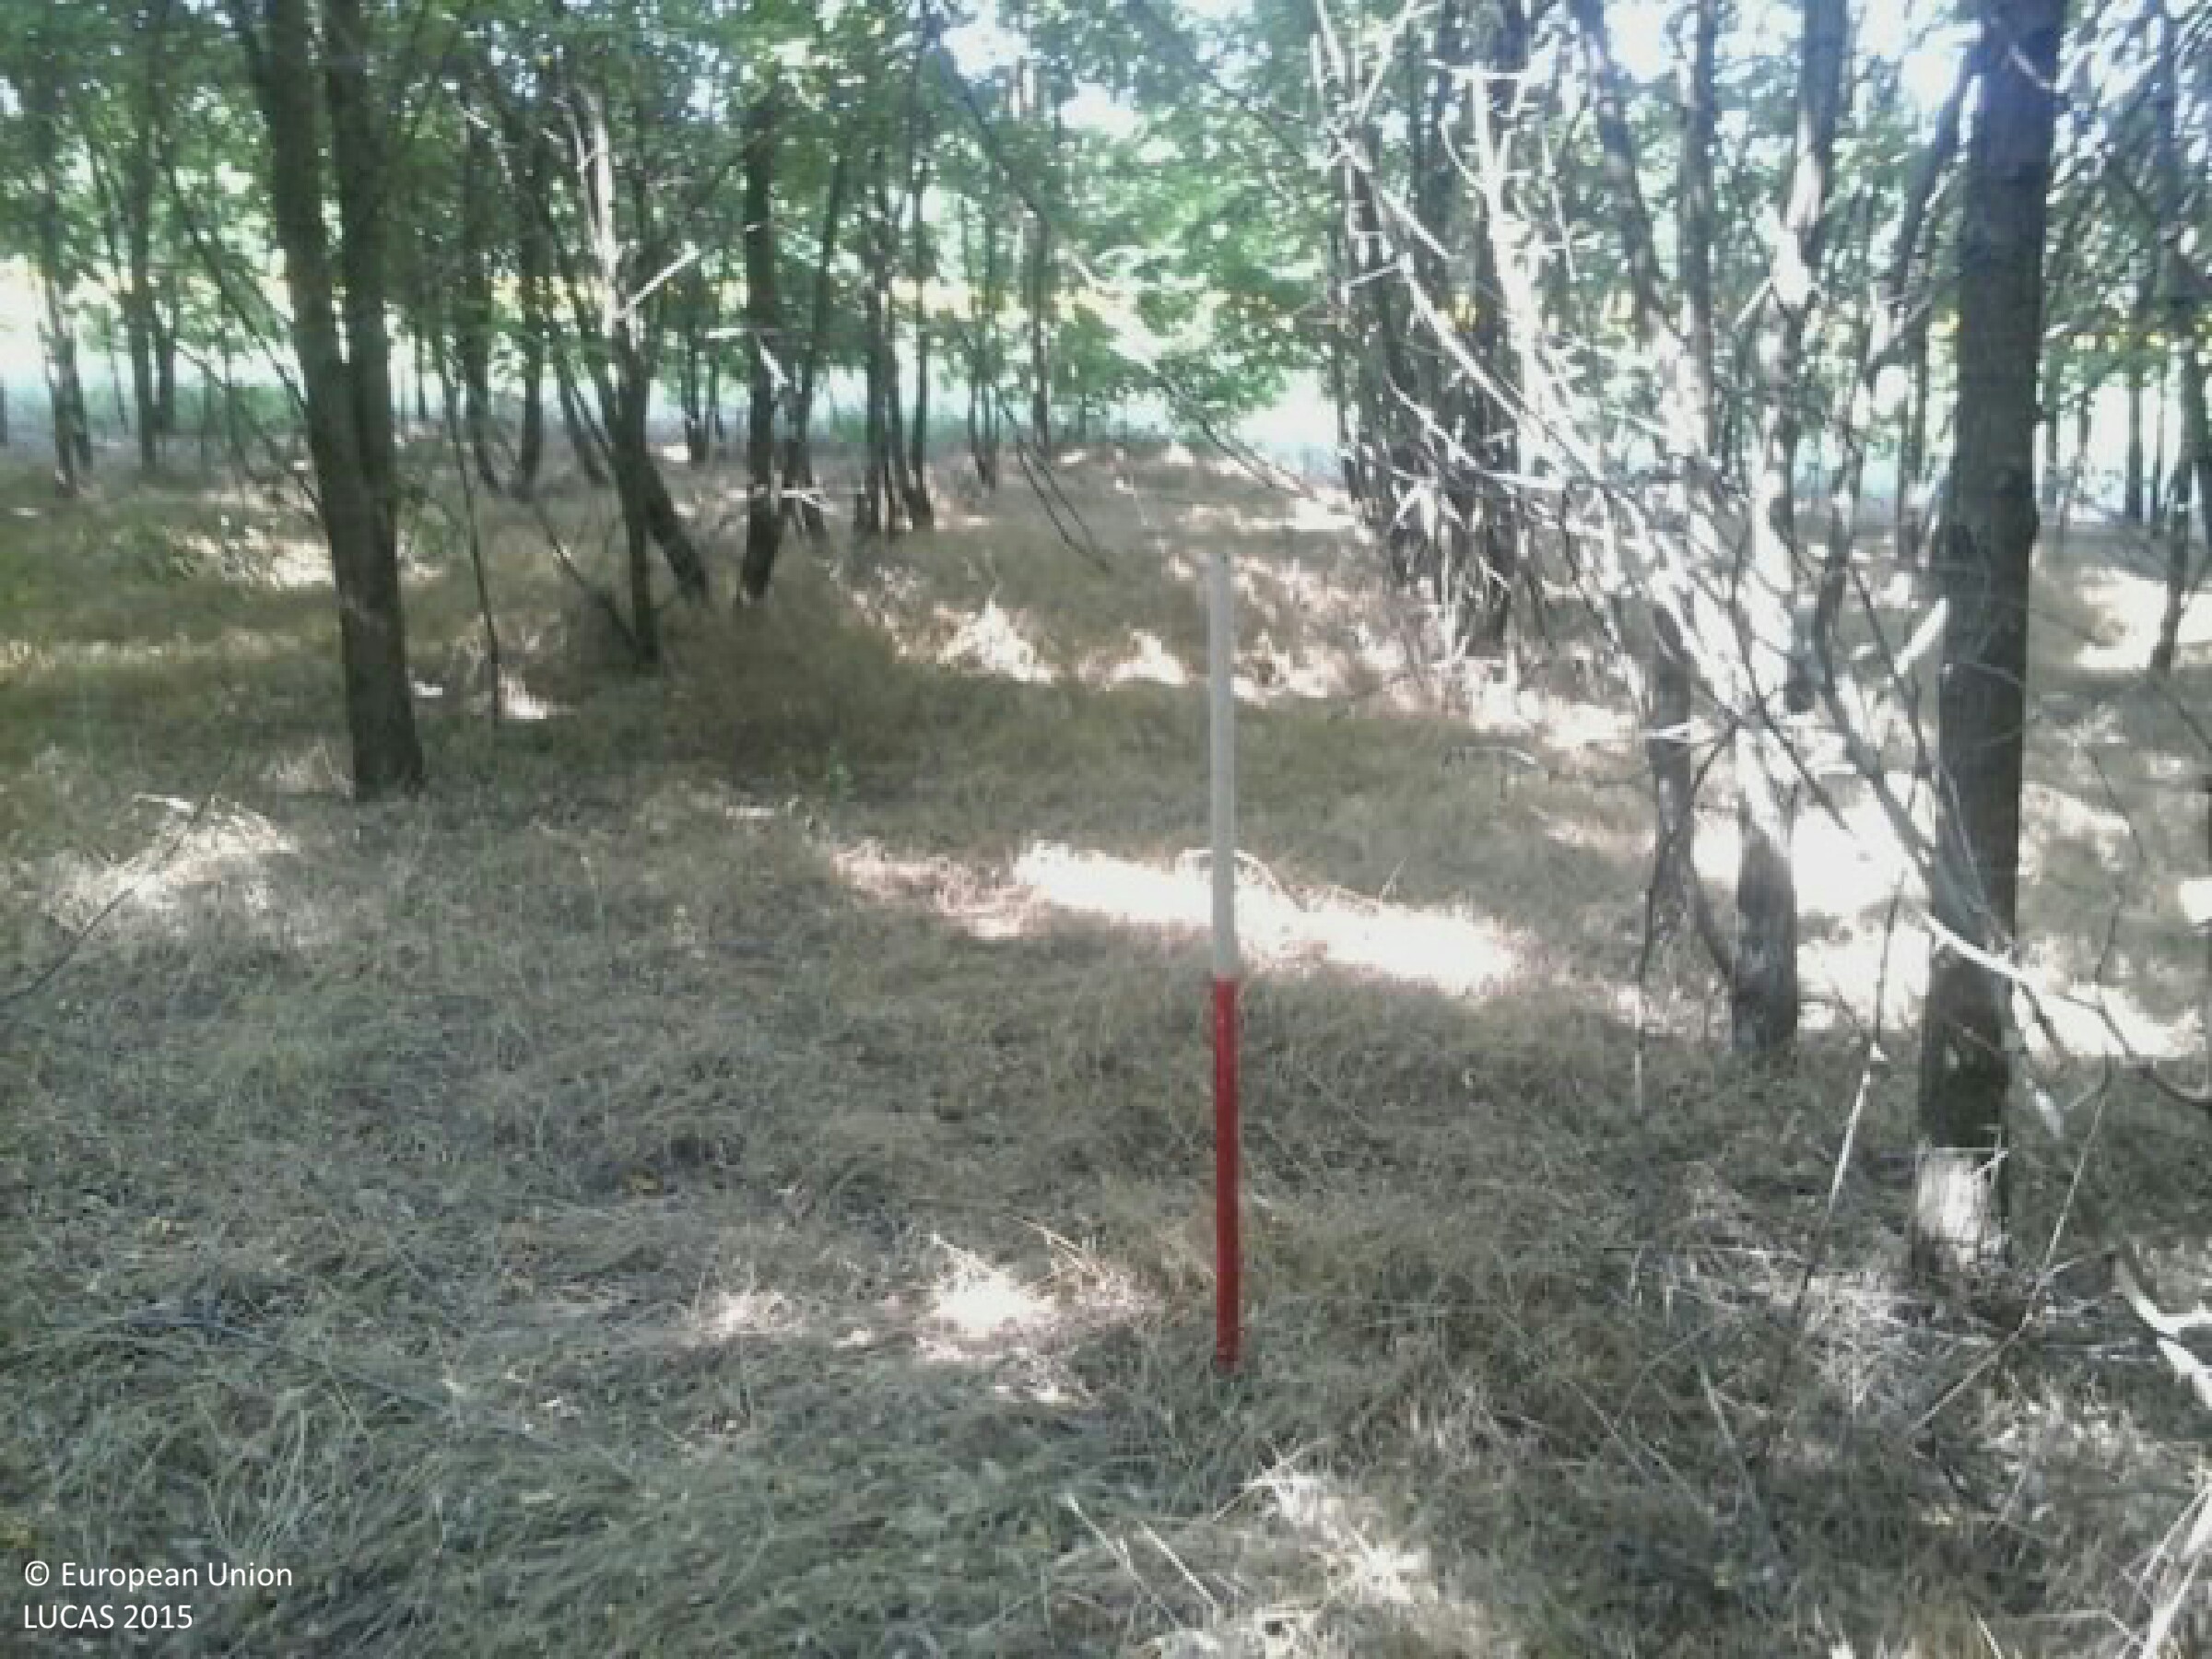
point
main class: Woodland
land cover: Broadleaved woodland
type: mesophytic deciduous forest
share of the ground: > 75 %
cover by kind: broadleaved forest trees 75 %, herbaceous plants 25 %
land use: Forestry
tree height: > 5 m
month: July
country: HU
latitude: 46.7539
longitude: 18.9556
